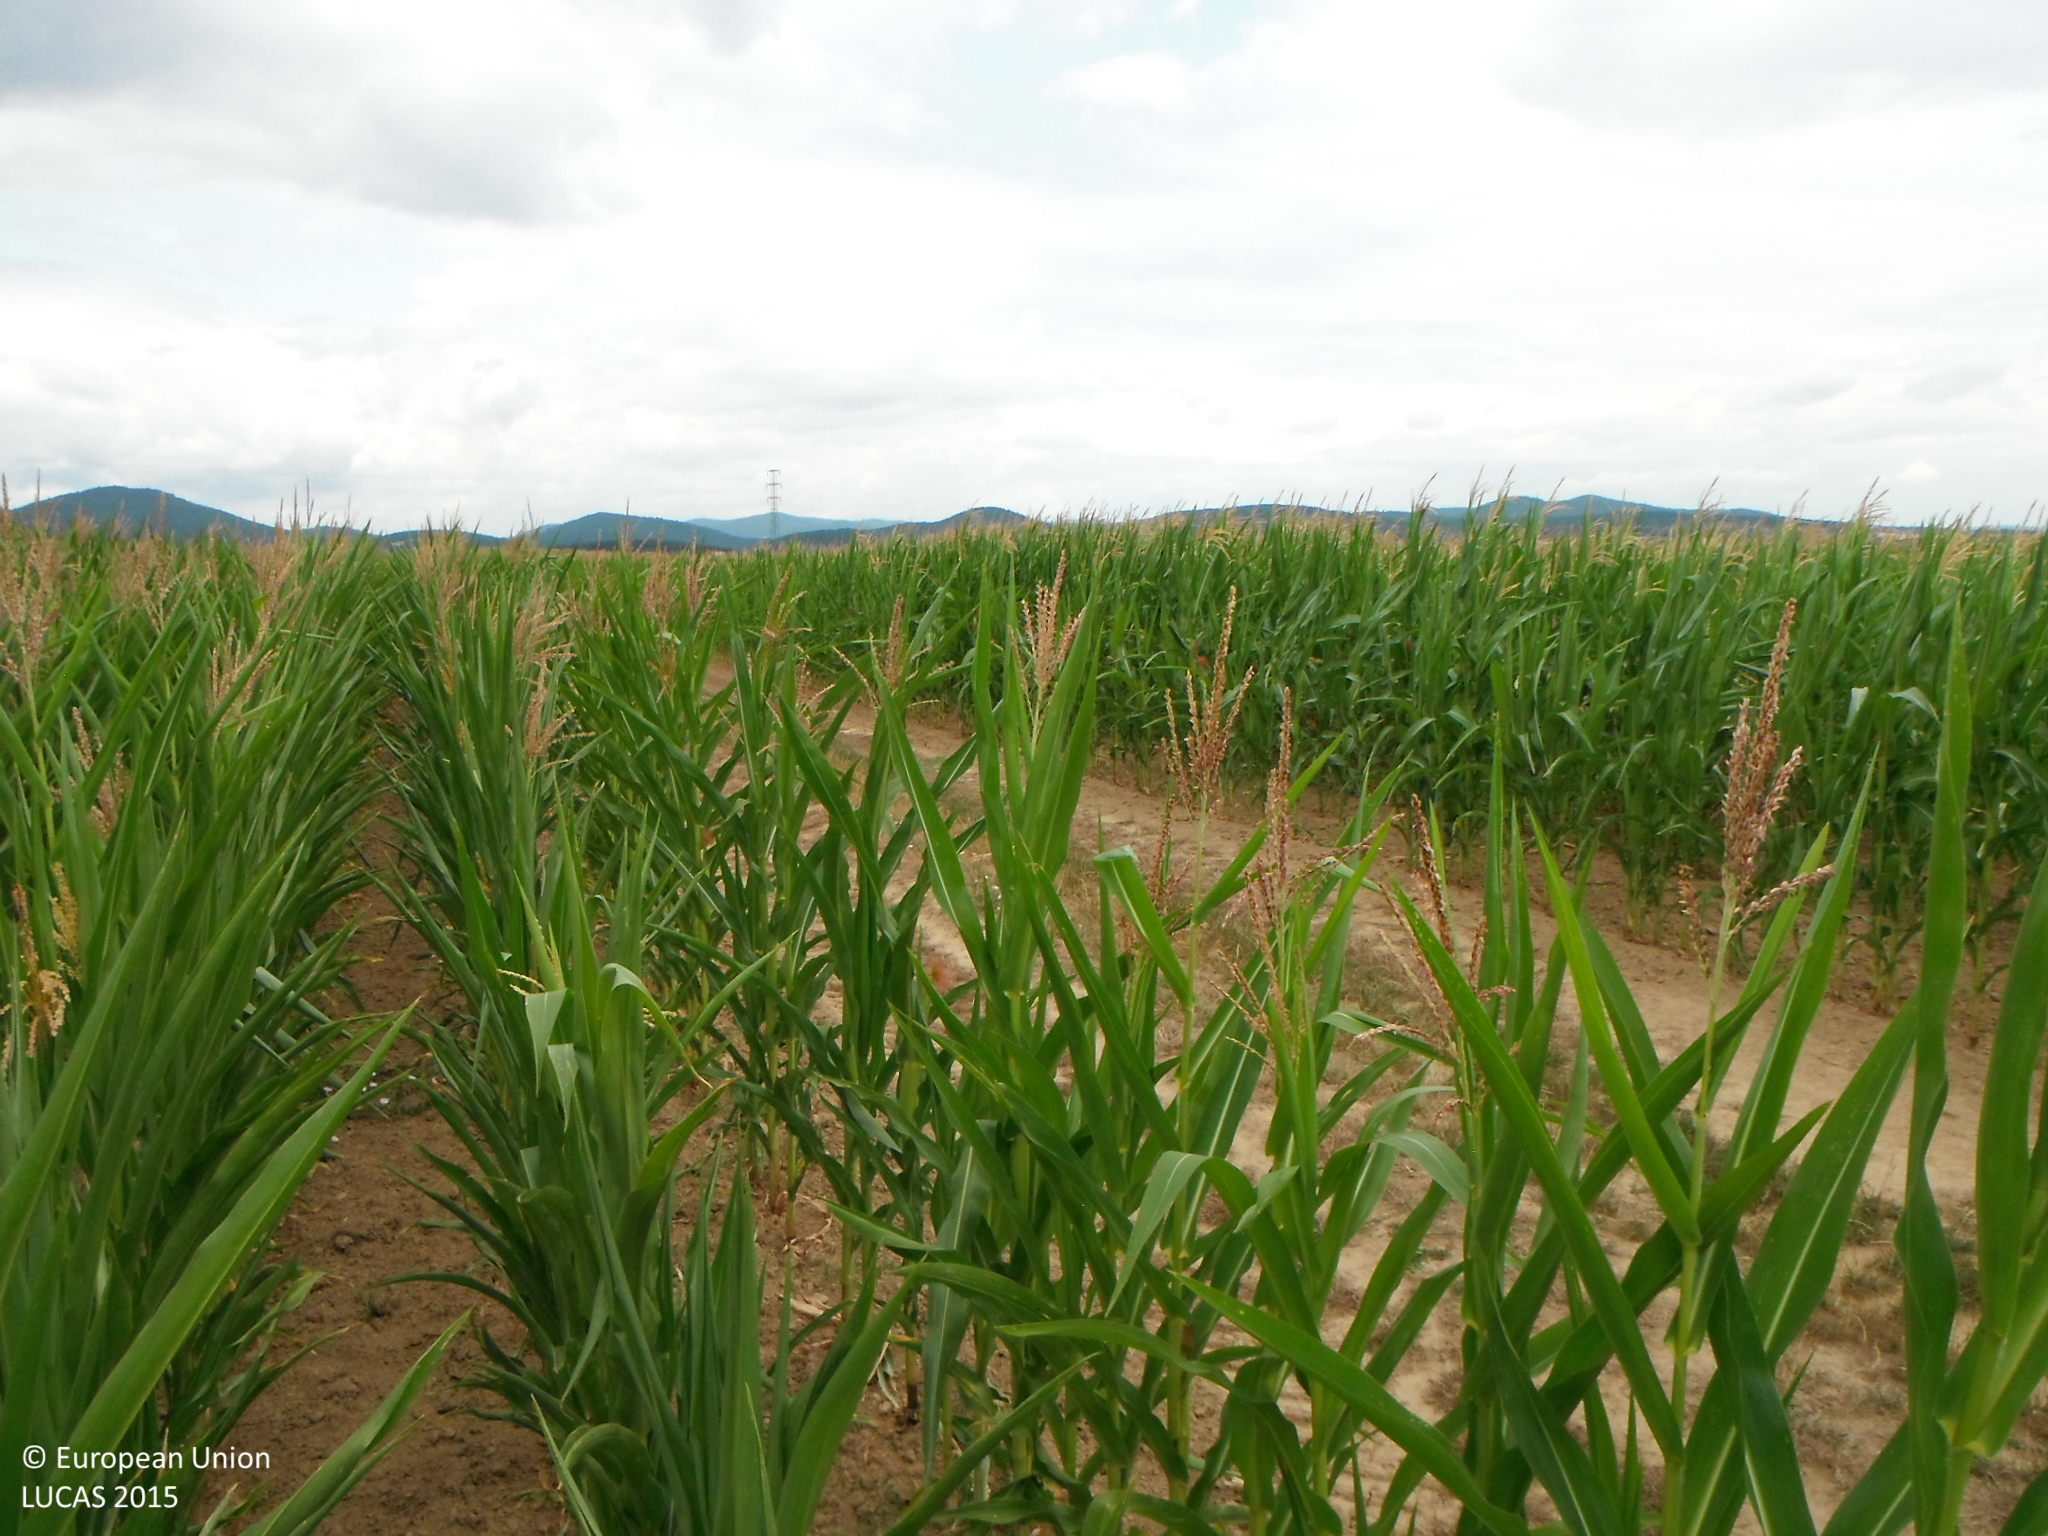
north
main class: Cropland
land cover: Maize
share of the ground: > 75 %
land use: Agriculture (excluding fallow land and kitchen gardens)
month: July
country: SK
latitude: 48.2728
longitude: 18.9798
